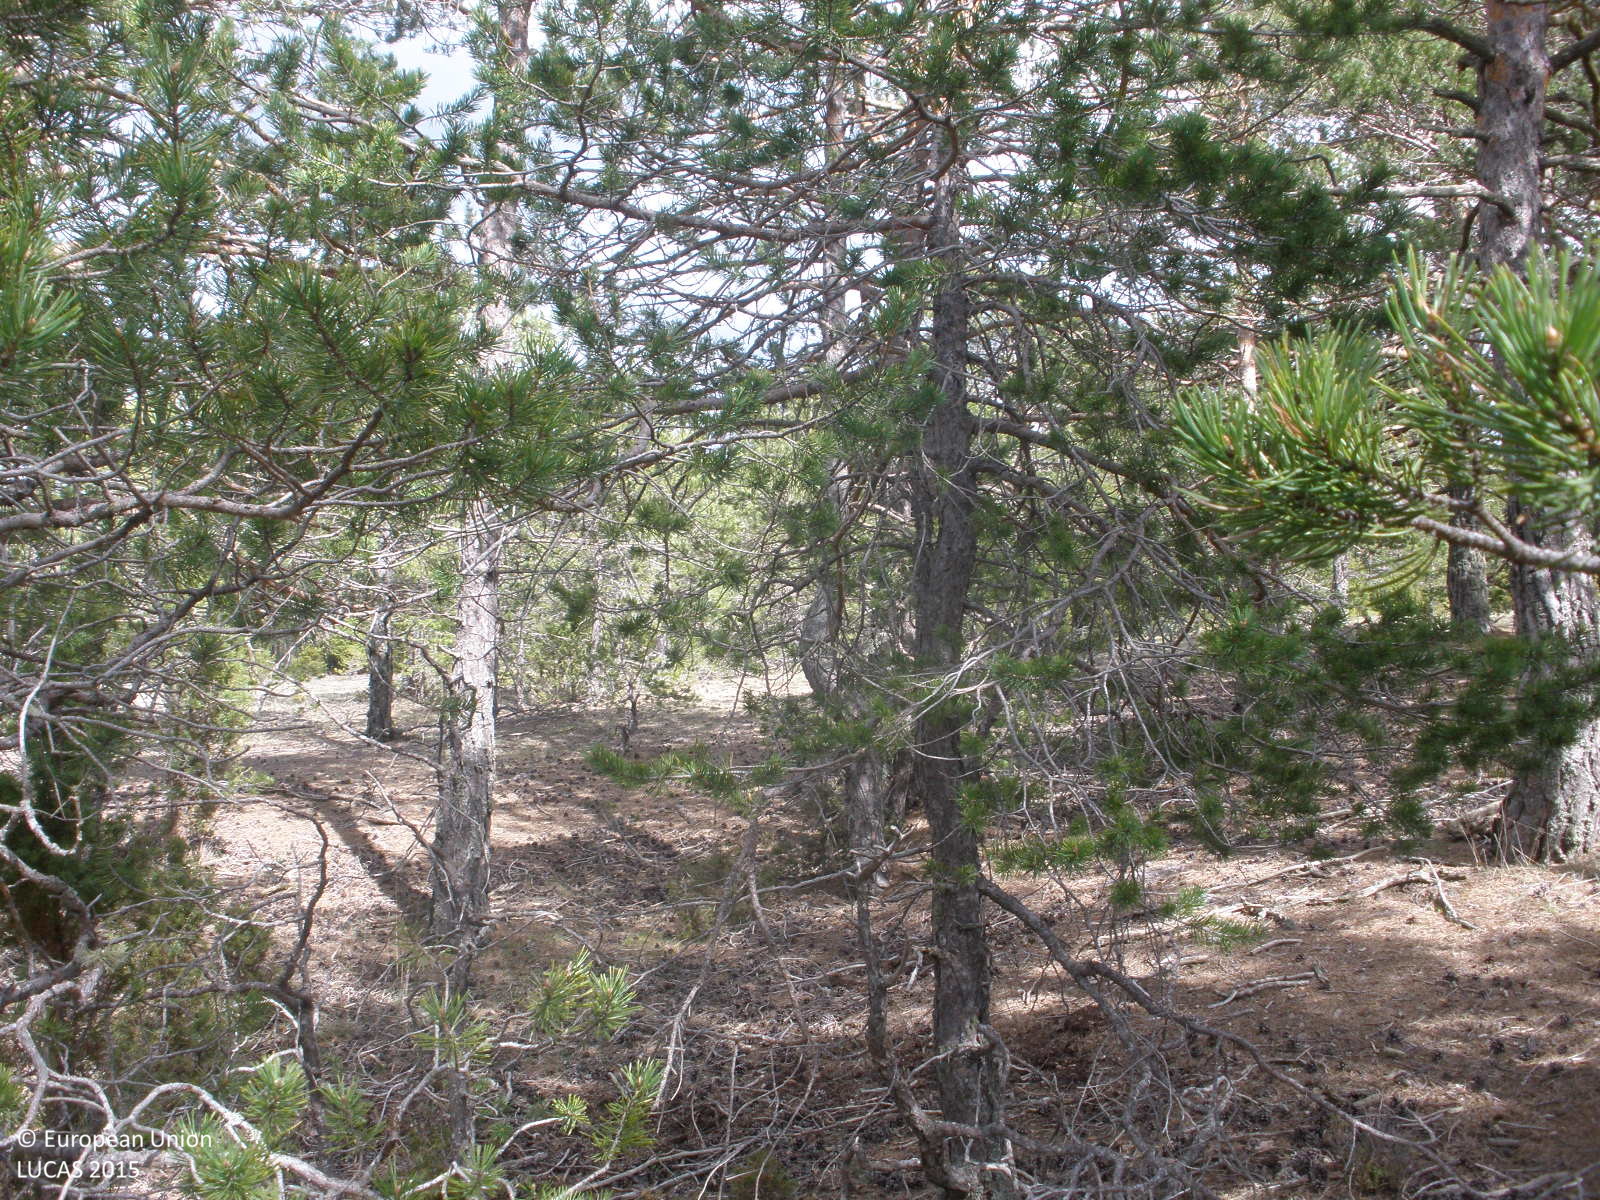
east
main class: Woodland
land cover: Pine dominated coniferous woodland
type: coniferous forest of the mediterranean region
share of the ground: 50 - 75 %
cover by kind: coniferous forest trees 70 %, herbaceous plants 20 %, shrubs 10 %
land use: Forestry
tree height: > 5 m
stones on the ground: < 10 %
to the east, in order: Pine dominated coniferous woodland; Tracks; Pine dominated coniferous woodland
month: April
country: ES
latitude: 40.3999
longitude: -0.7899
